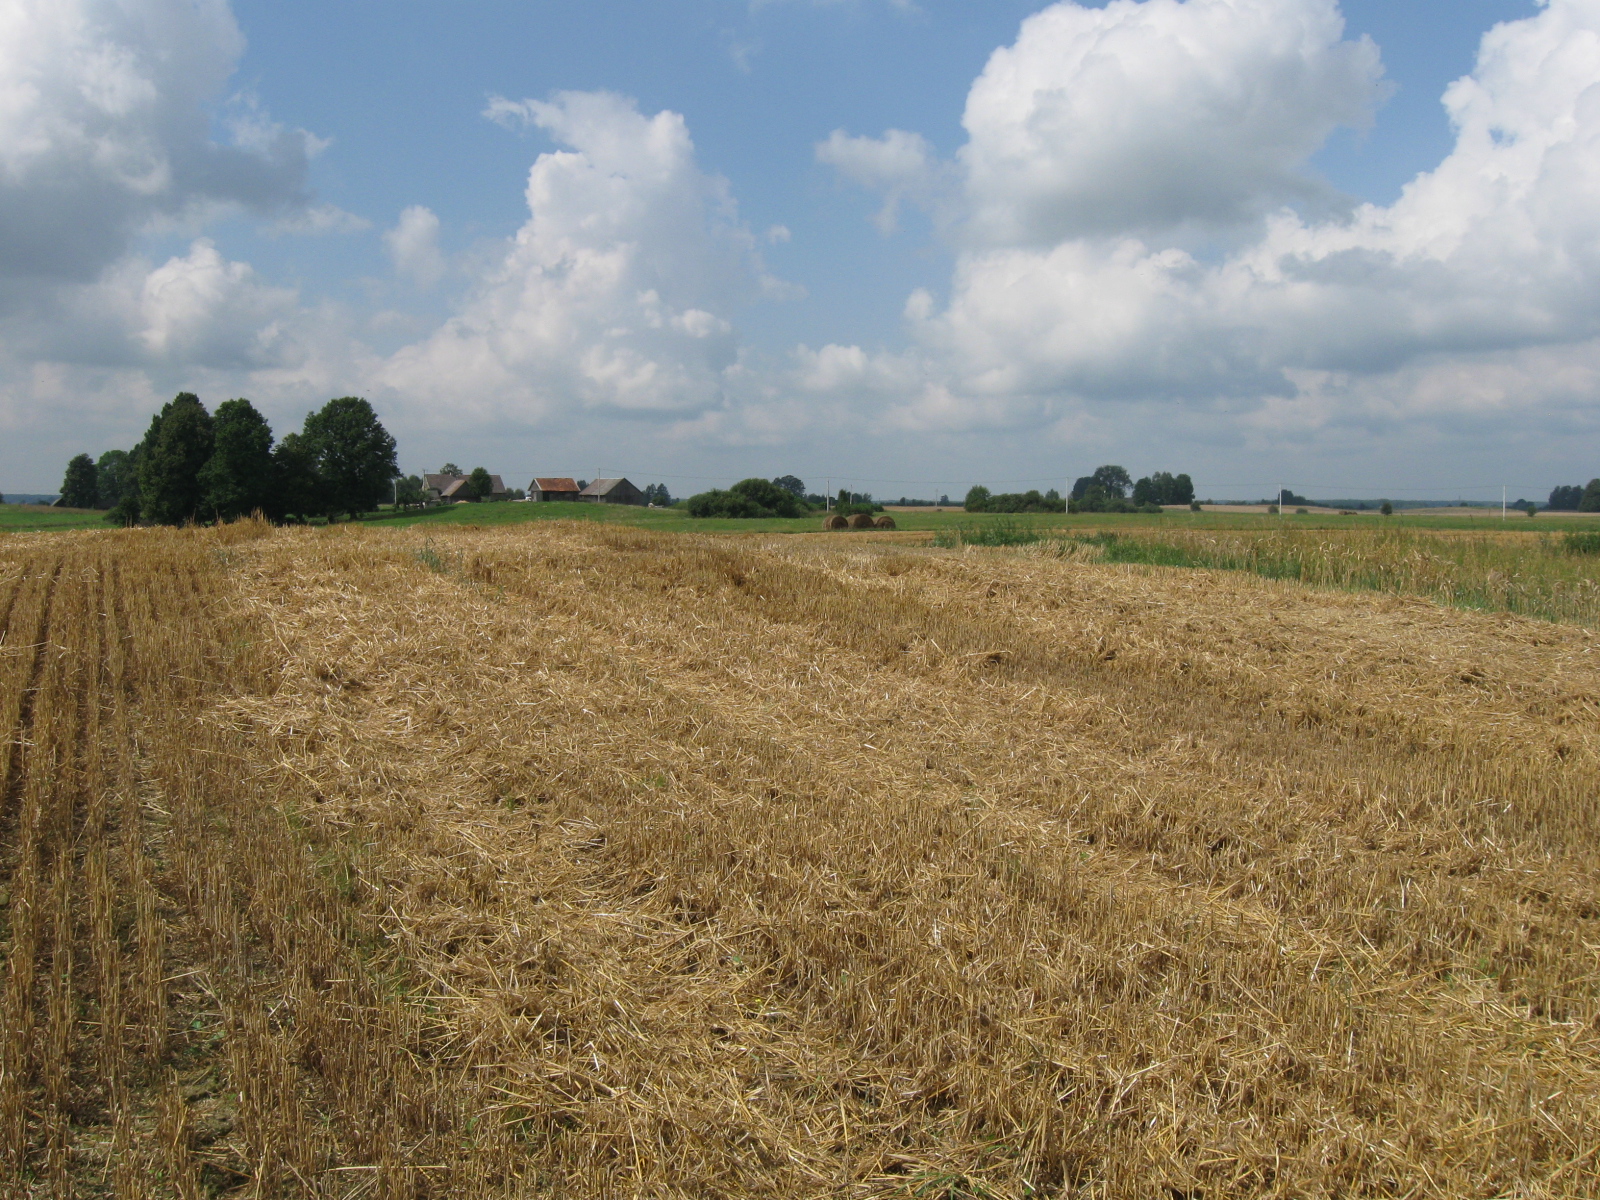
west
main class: Cropland
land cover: Common wheat
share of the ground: > 75 %
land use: Agriculture (excluding fallow land and kitchen gardens)
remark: Harvested field
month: August
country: LT
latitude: 54.7034
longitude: 23.6635
